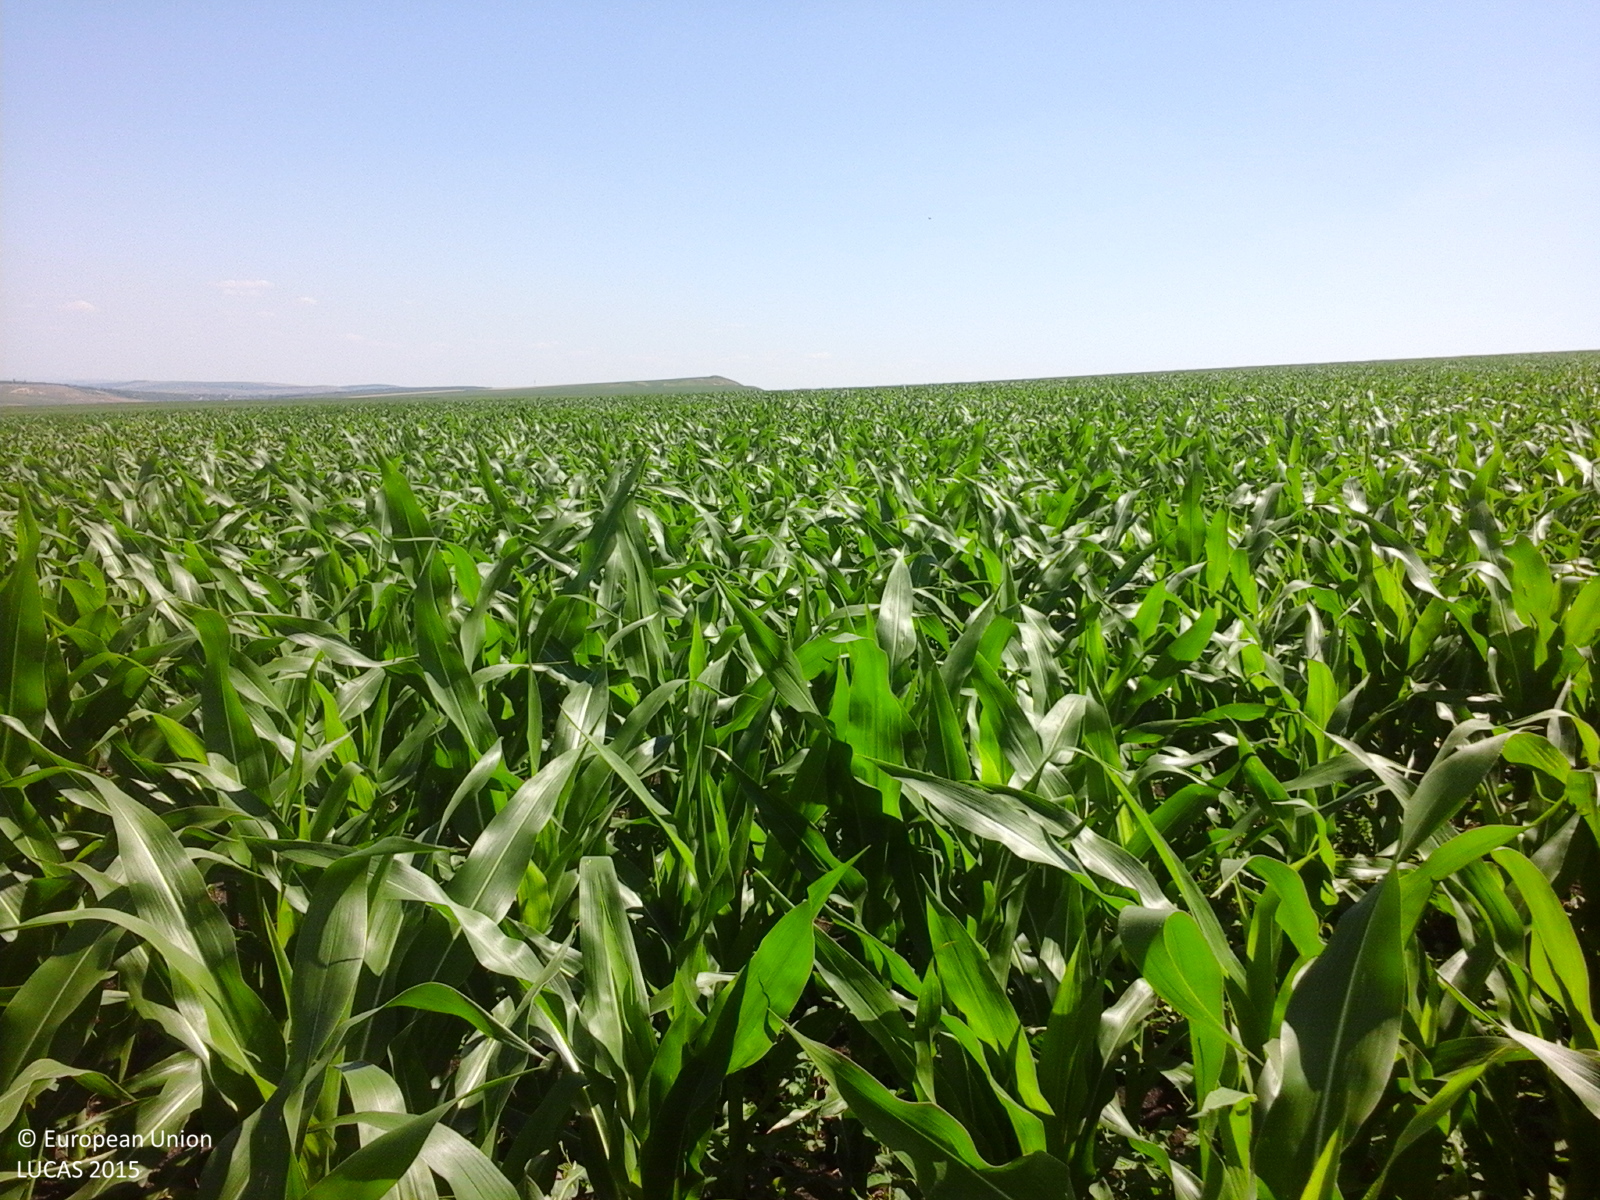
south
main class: Cropland
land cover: Maize
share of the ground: > 75 %
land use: Agriculture (excluding fallow land and kitchen gardens)
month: June
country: RO
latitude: 47.5284
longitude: 27.1490
